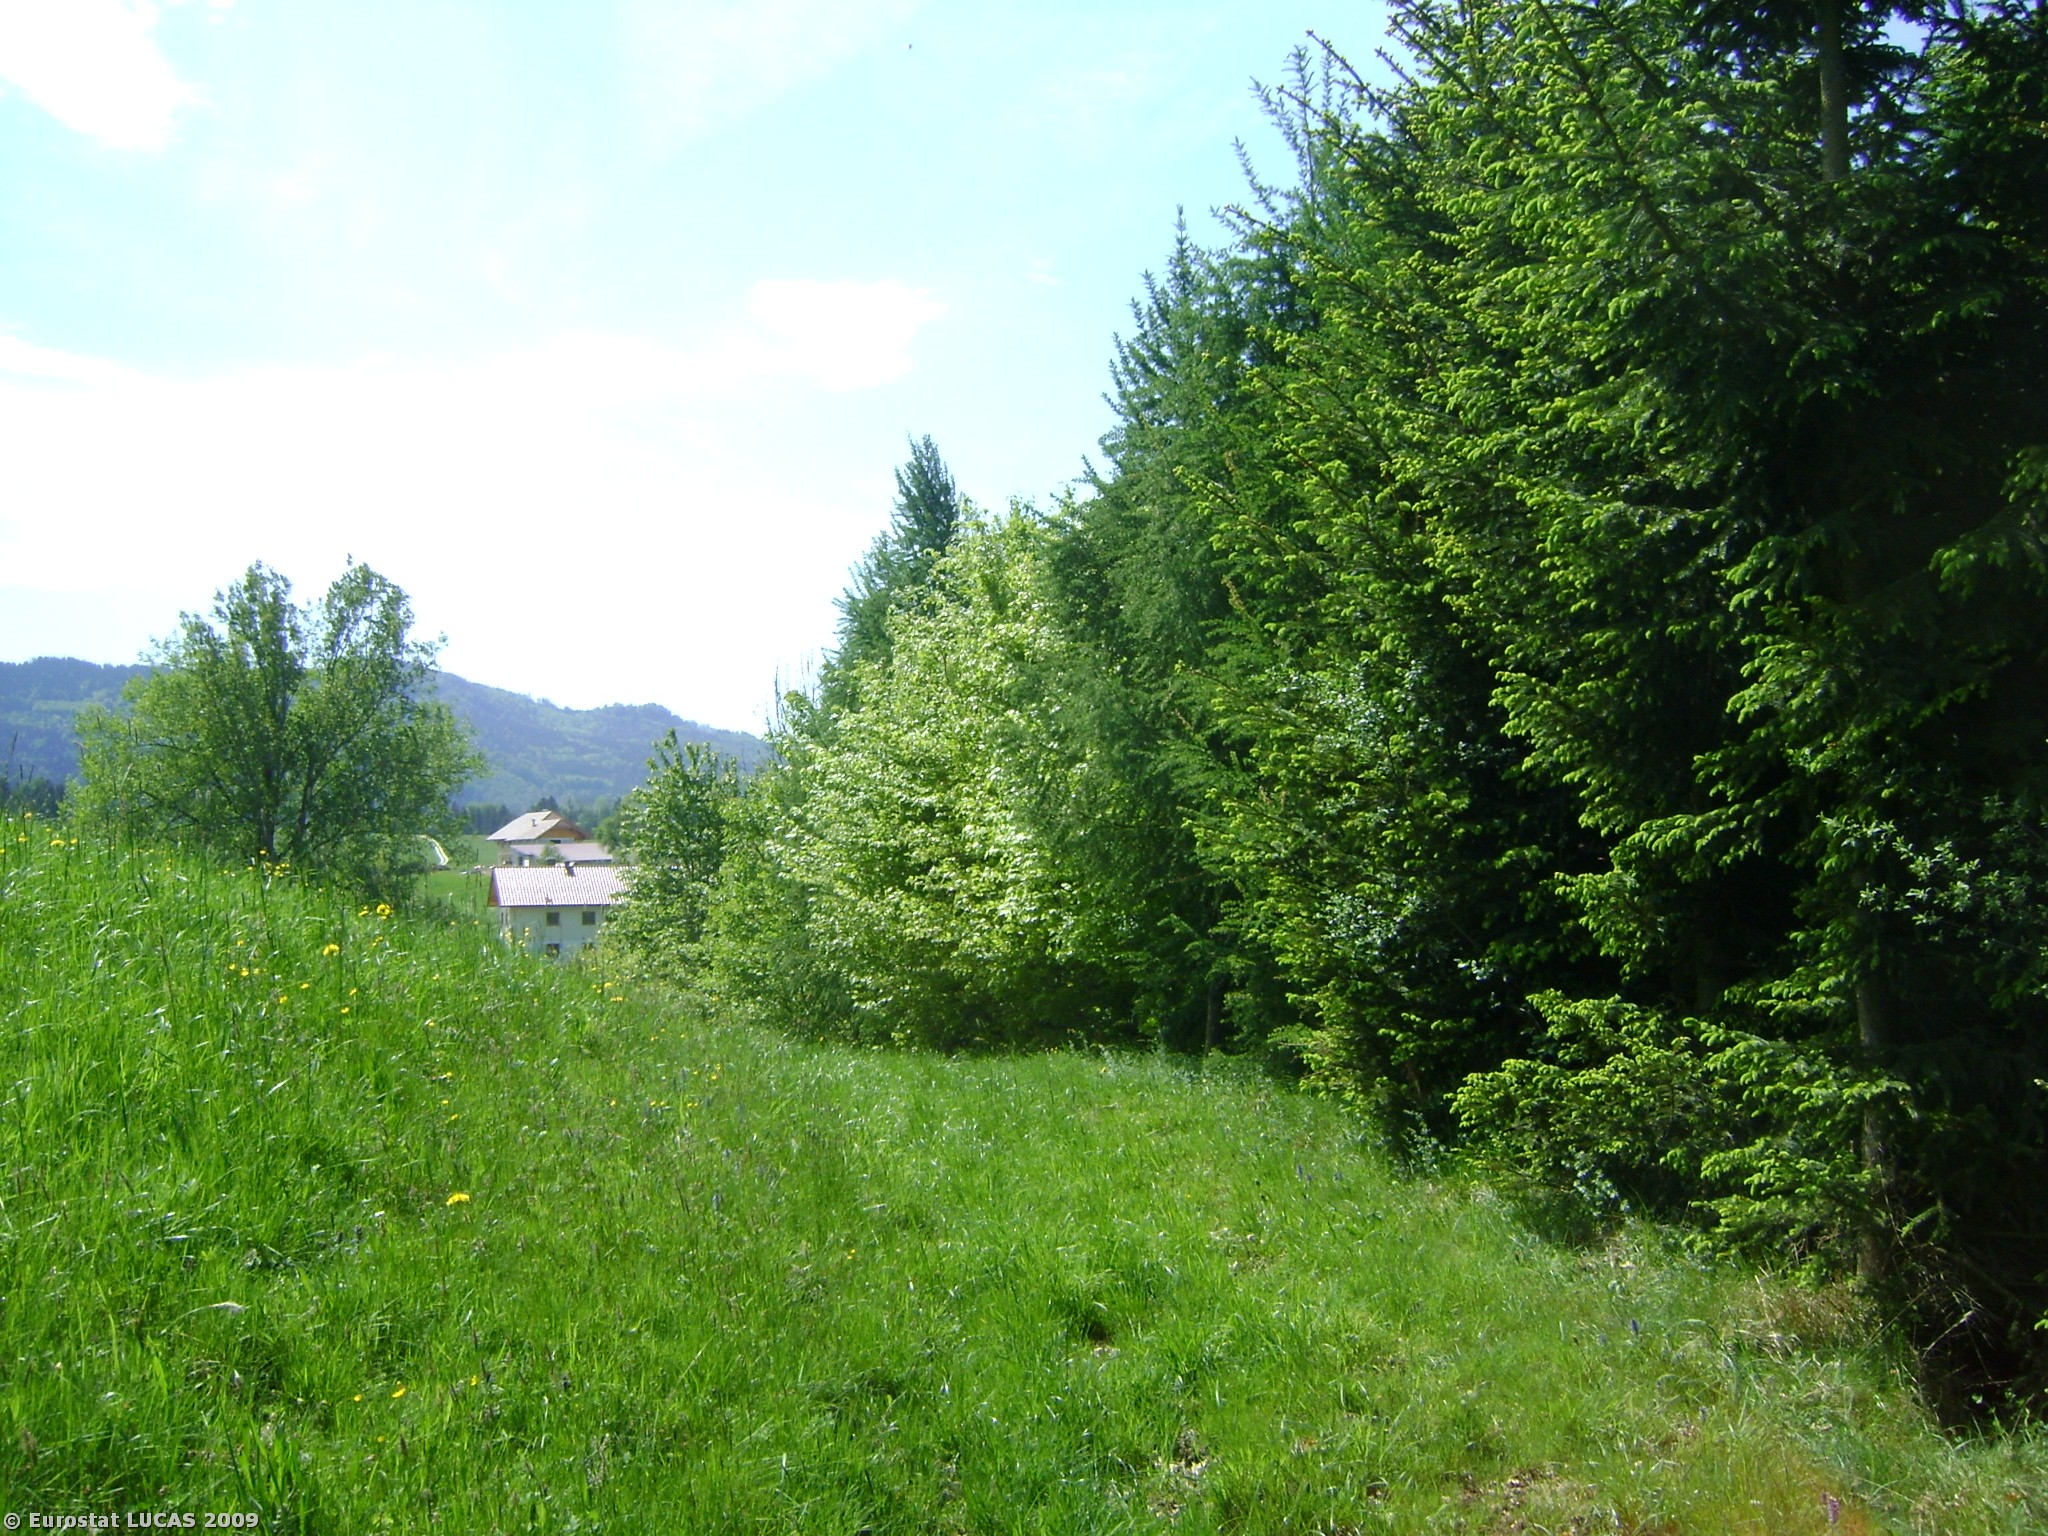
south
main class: Grassland
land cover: Grassland without tree/shrub cover
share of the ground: > 75 %
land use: Agriculture (excluding fallow land and kitchen gardens)
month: May
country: AT
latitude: 47.9243
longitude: 13.2241
